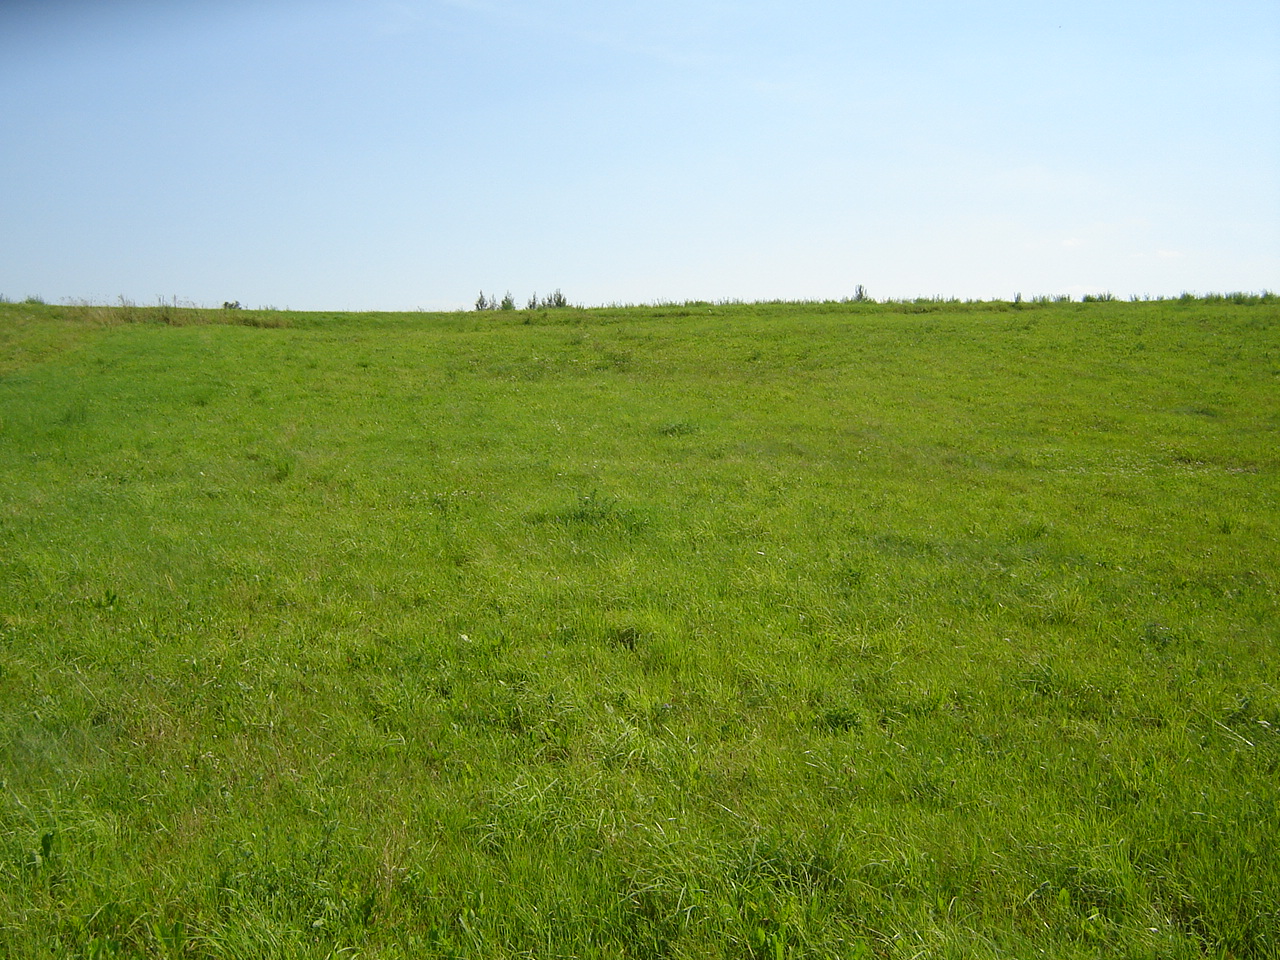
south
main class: Grassland
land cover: Grassland without tree/shrub cover
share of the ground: > 75 %
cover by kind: herbaceous plants 100 %
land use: Agriculture (excluding fallow land and kitchen gardens)
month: August
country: LT
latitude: 55.1553
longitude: 24.9743
